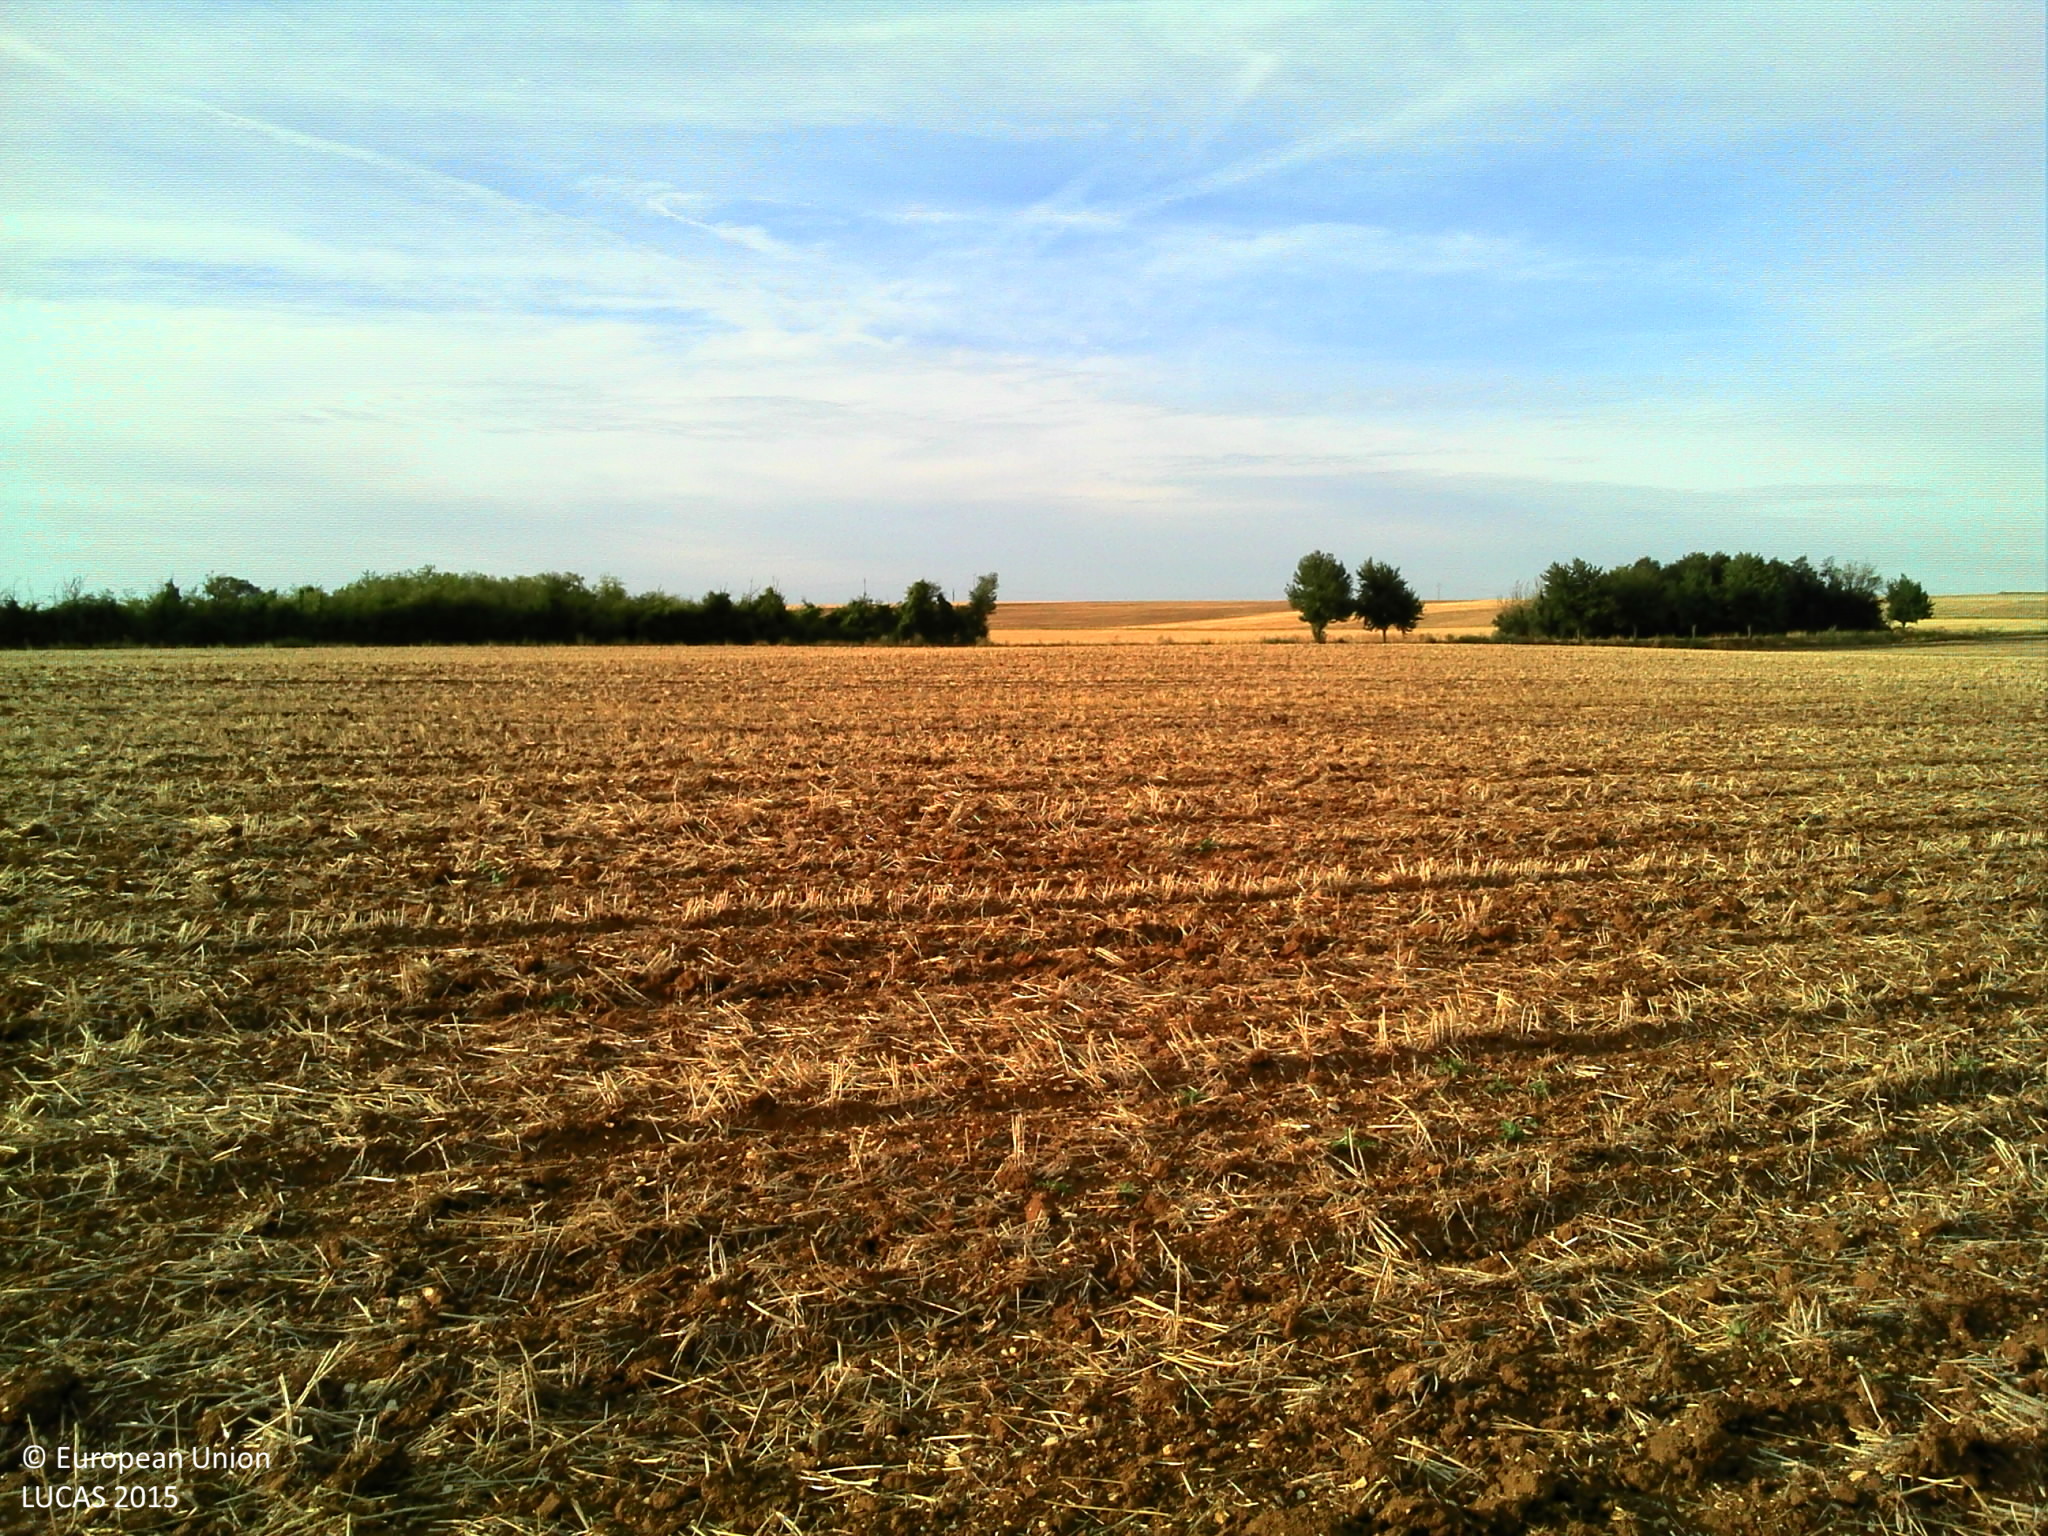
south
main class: Cropland
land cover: Common wheat
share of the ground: 10 - 25 %
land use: Agriculture (excluding fallow land and kitchen gardens)
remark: Tilled/Sowed
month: July
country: FR
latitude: 46.7835
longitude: 0.1414
